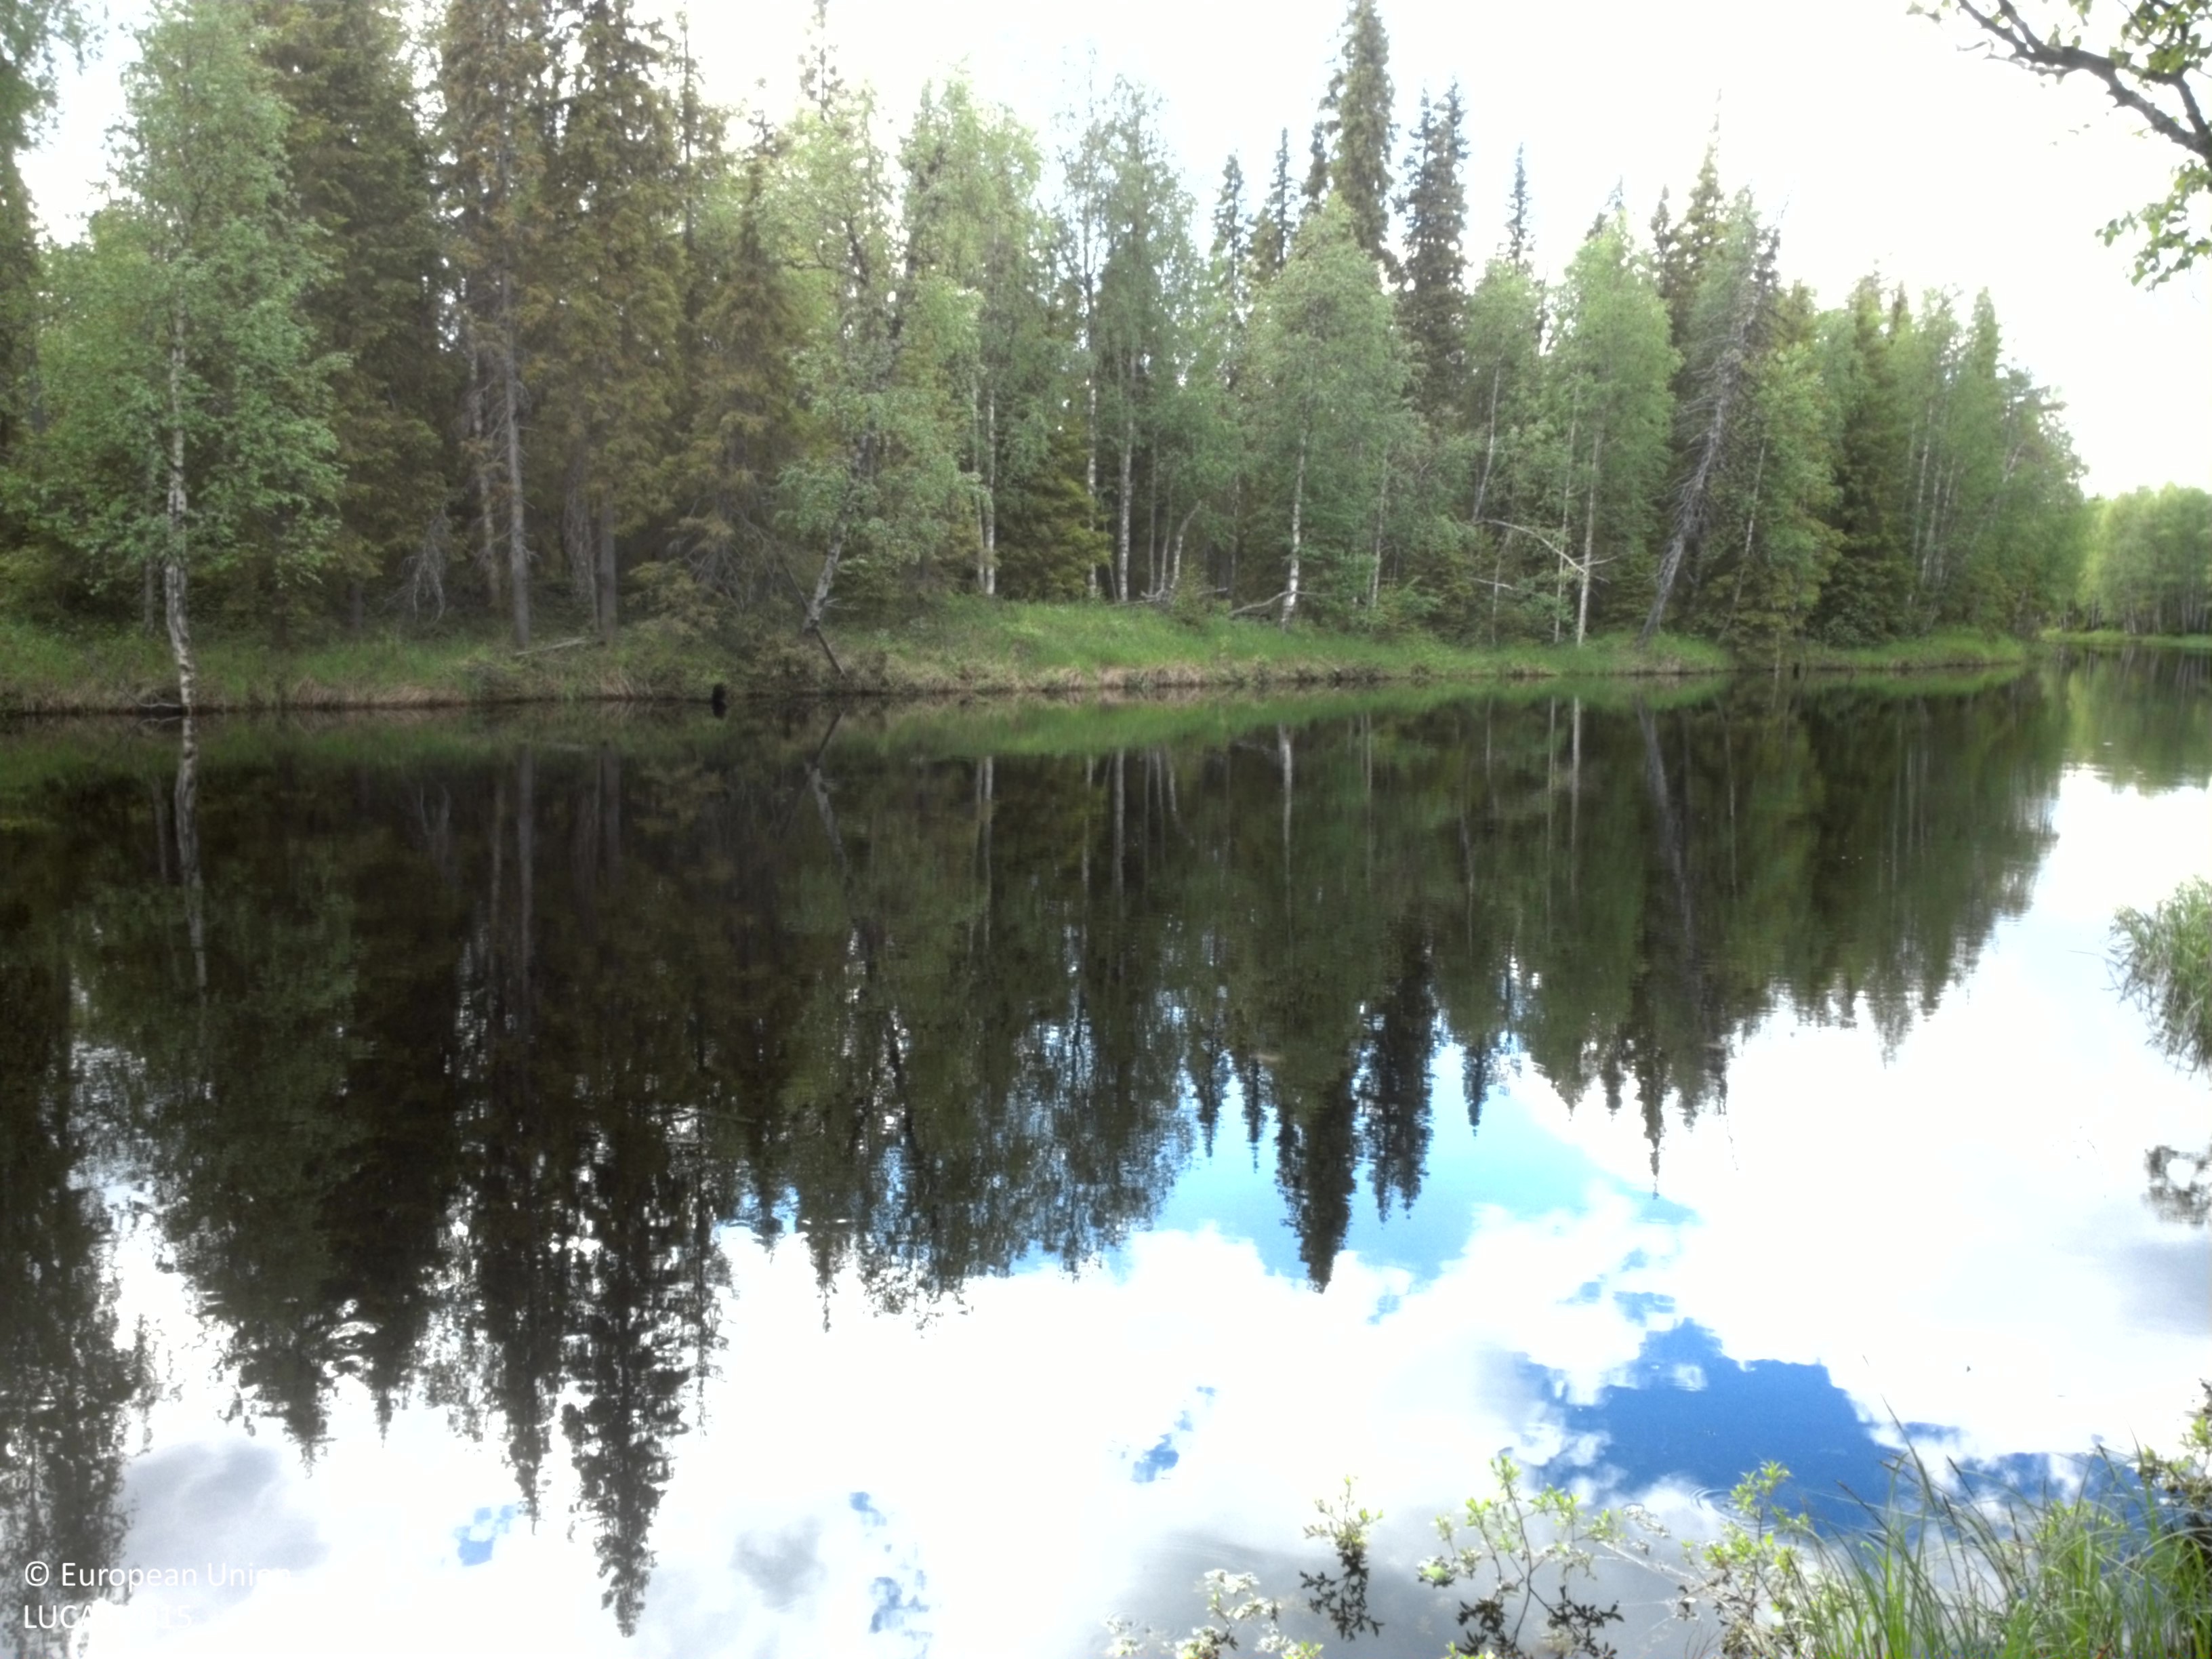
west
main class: Woodland
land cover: Spruce dominated mixed woodland
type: boreal forest
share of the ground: 50 - 75 %
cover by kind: shrubs 40 %, coniferous forest trees 35 %, broadleaved forest trees 25 %
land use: Forestry
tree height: > 5 m
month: June
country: SE
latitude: 66.4264
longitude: 22.3628
